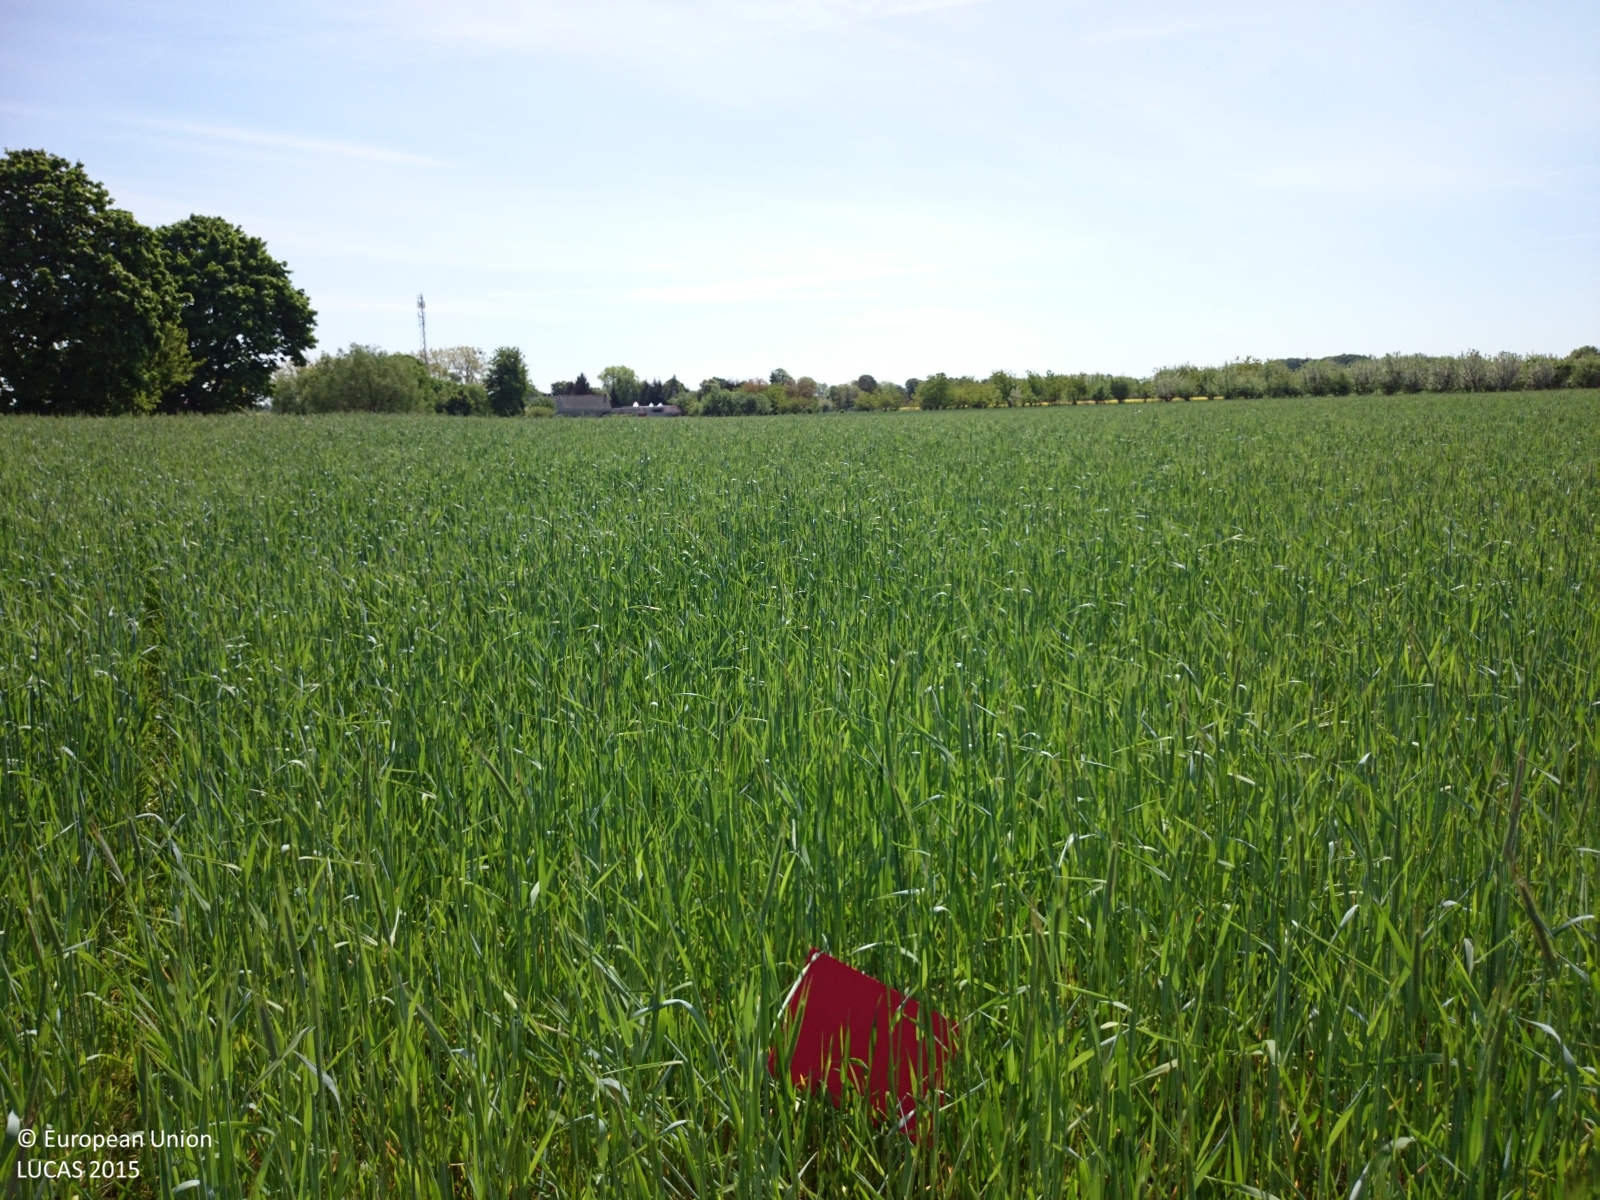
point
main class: Cropland
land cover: Common wheat
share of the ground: > 75 %
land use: Agriculture (excluding fallow land and kitchen gardens)
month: May
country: PL
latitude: 52.4452
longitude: 16.2889
